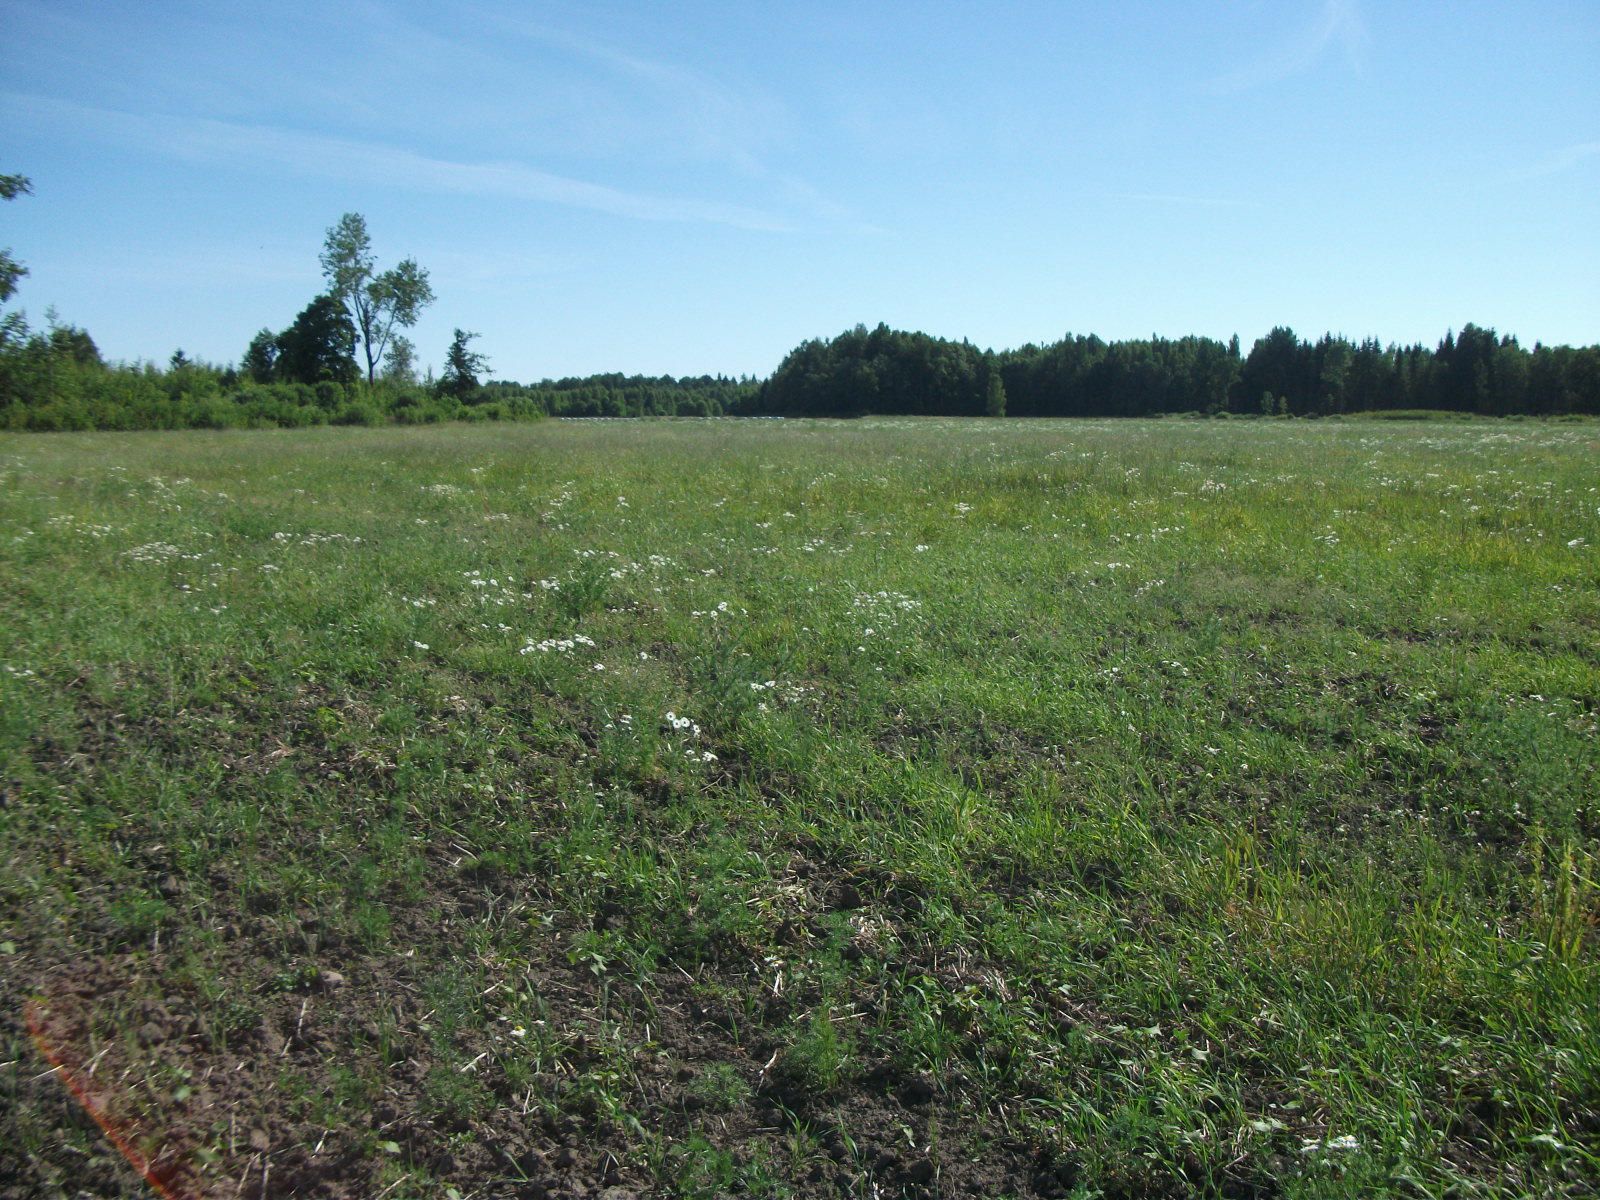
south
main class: Grassland
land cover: Spontaneously vegetated surfaces
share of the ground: > 75 %
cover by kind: herbaceous plants 80 %, unconsolidated bare surface 20 %
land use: Fallow land
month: July
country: LV
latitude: 56.7436
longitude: 26.3790
